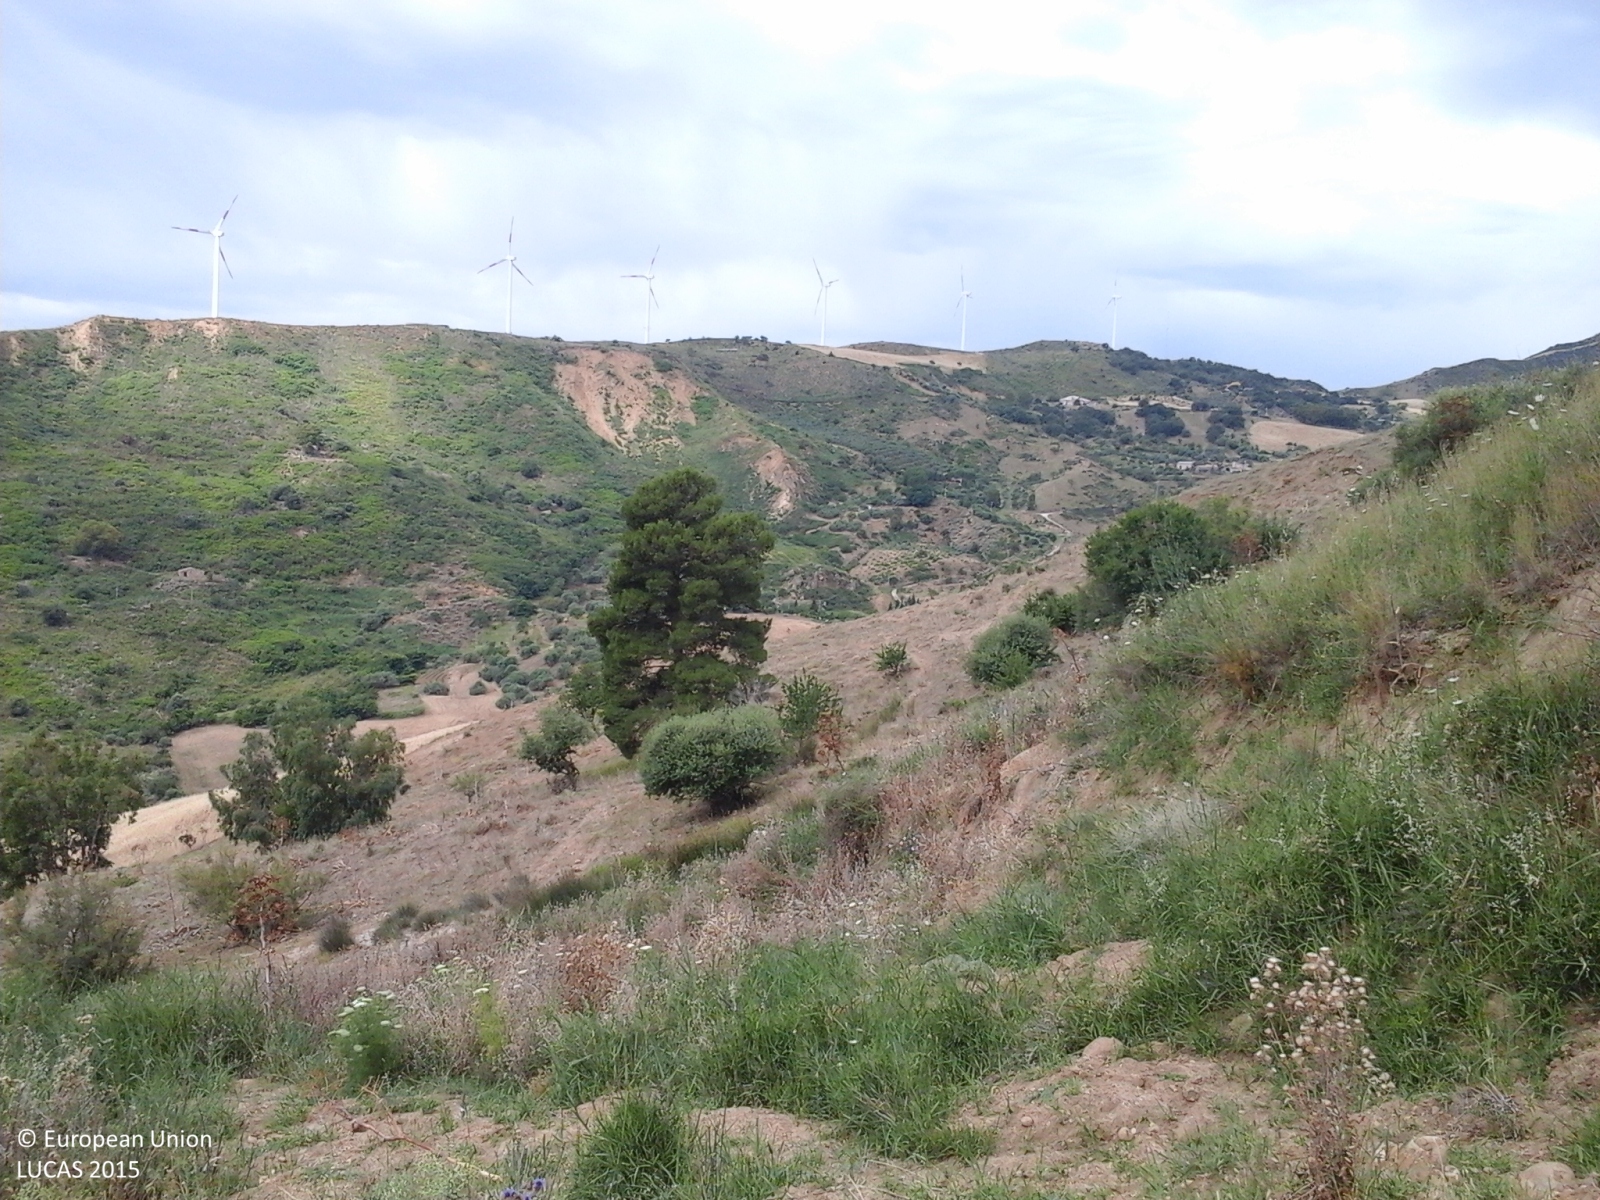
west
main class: Grassland
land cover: Grassland without tree/shrub cover
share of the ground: > 75 %
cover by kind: herbaceous plants 100 %
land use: Agriculture (excluding fallow land and kitchen gardens)
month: June
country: IT
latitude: 37.8757
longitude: 13.6912
